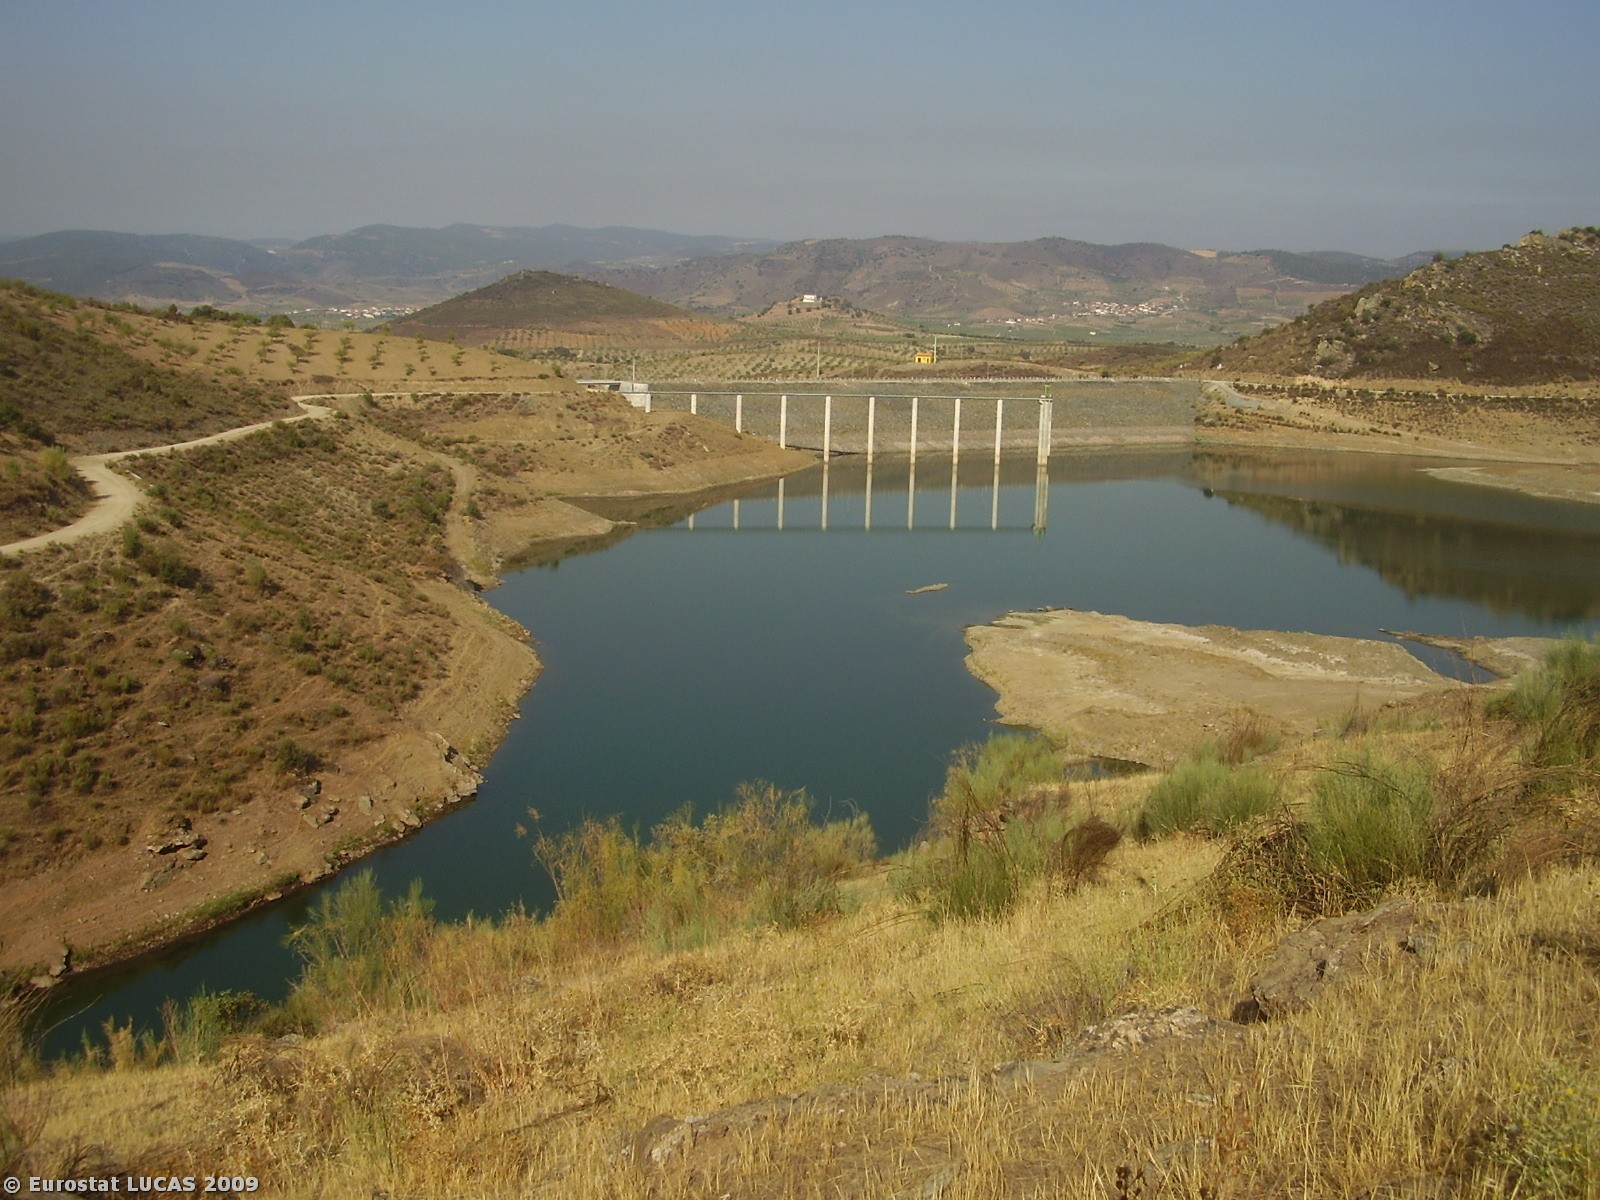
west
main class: Grassland
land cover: Spontaneously vegetated surfaces
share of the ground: > 75 %
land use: Fallow land
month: August
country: PT
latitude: 41.3301
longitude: -7.0193
